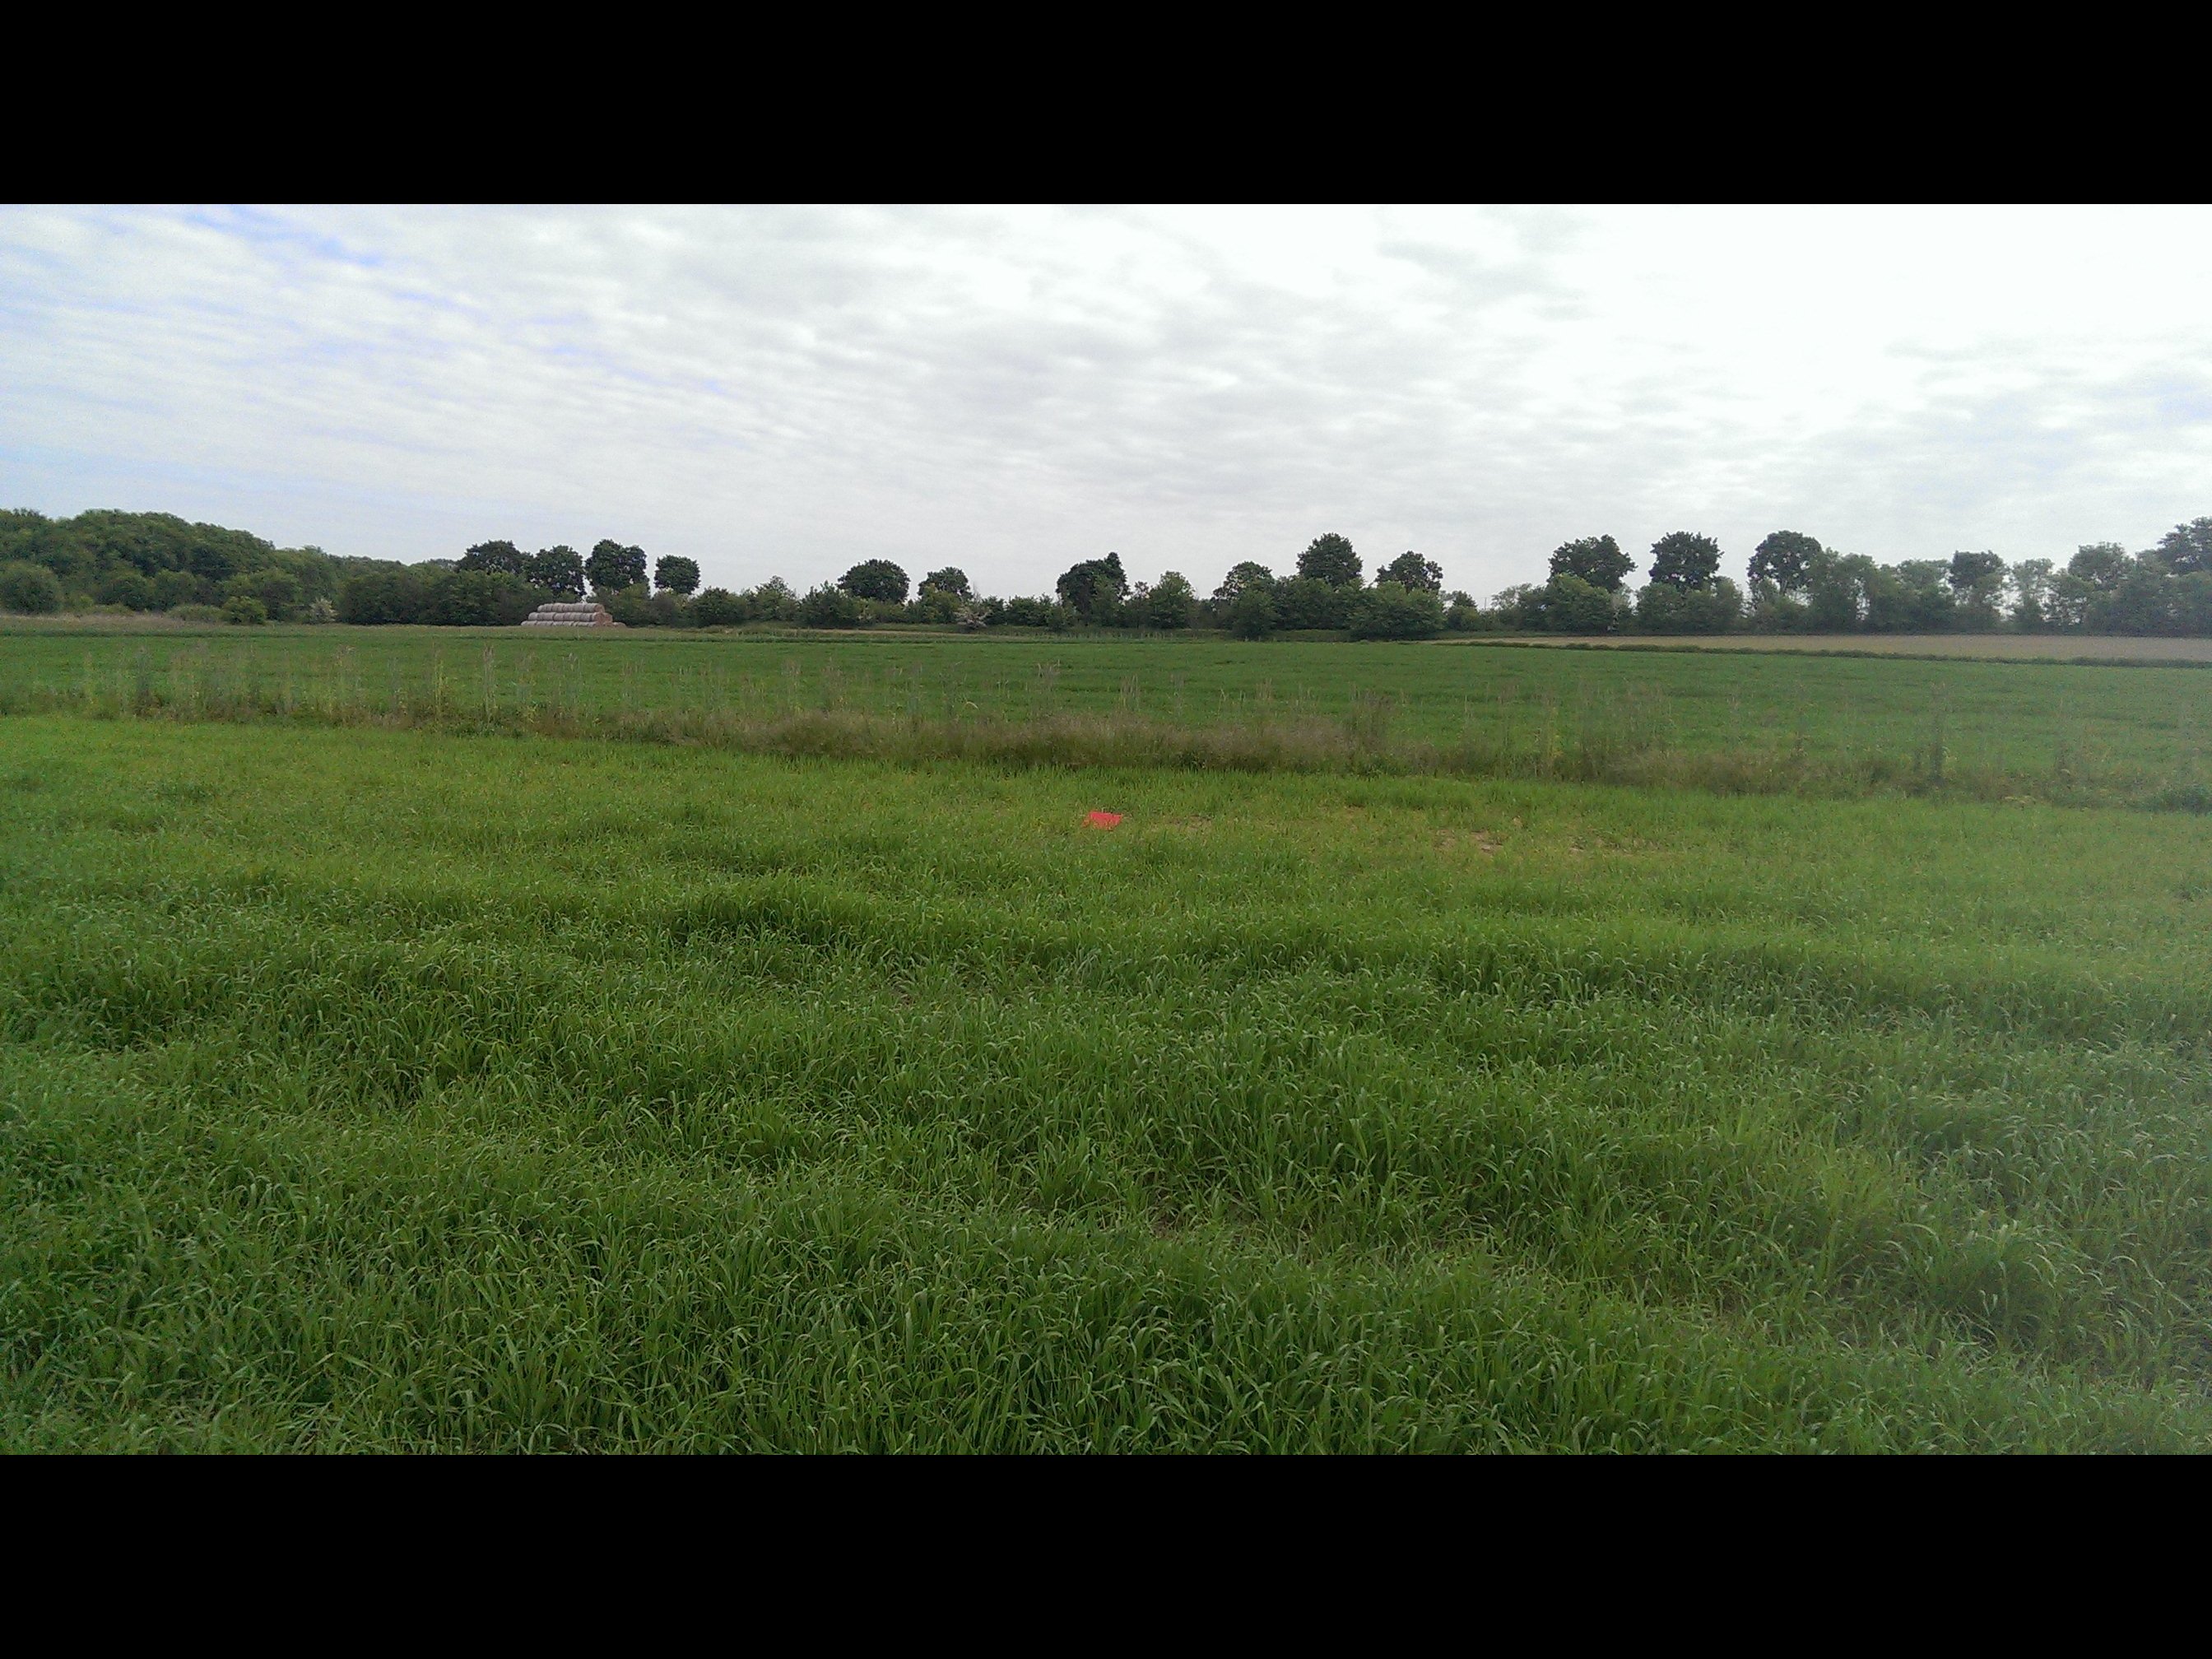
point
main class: Cropland
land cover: Barley
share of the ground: > 75 %
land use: Agriculture (excluding fallow land and kitchen gardens)
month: May
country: PL
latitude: 52.4094
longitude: 16.2838
